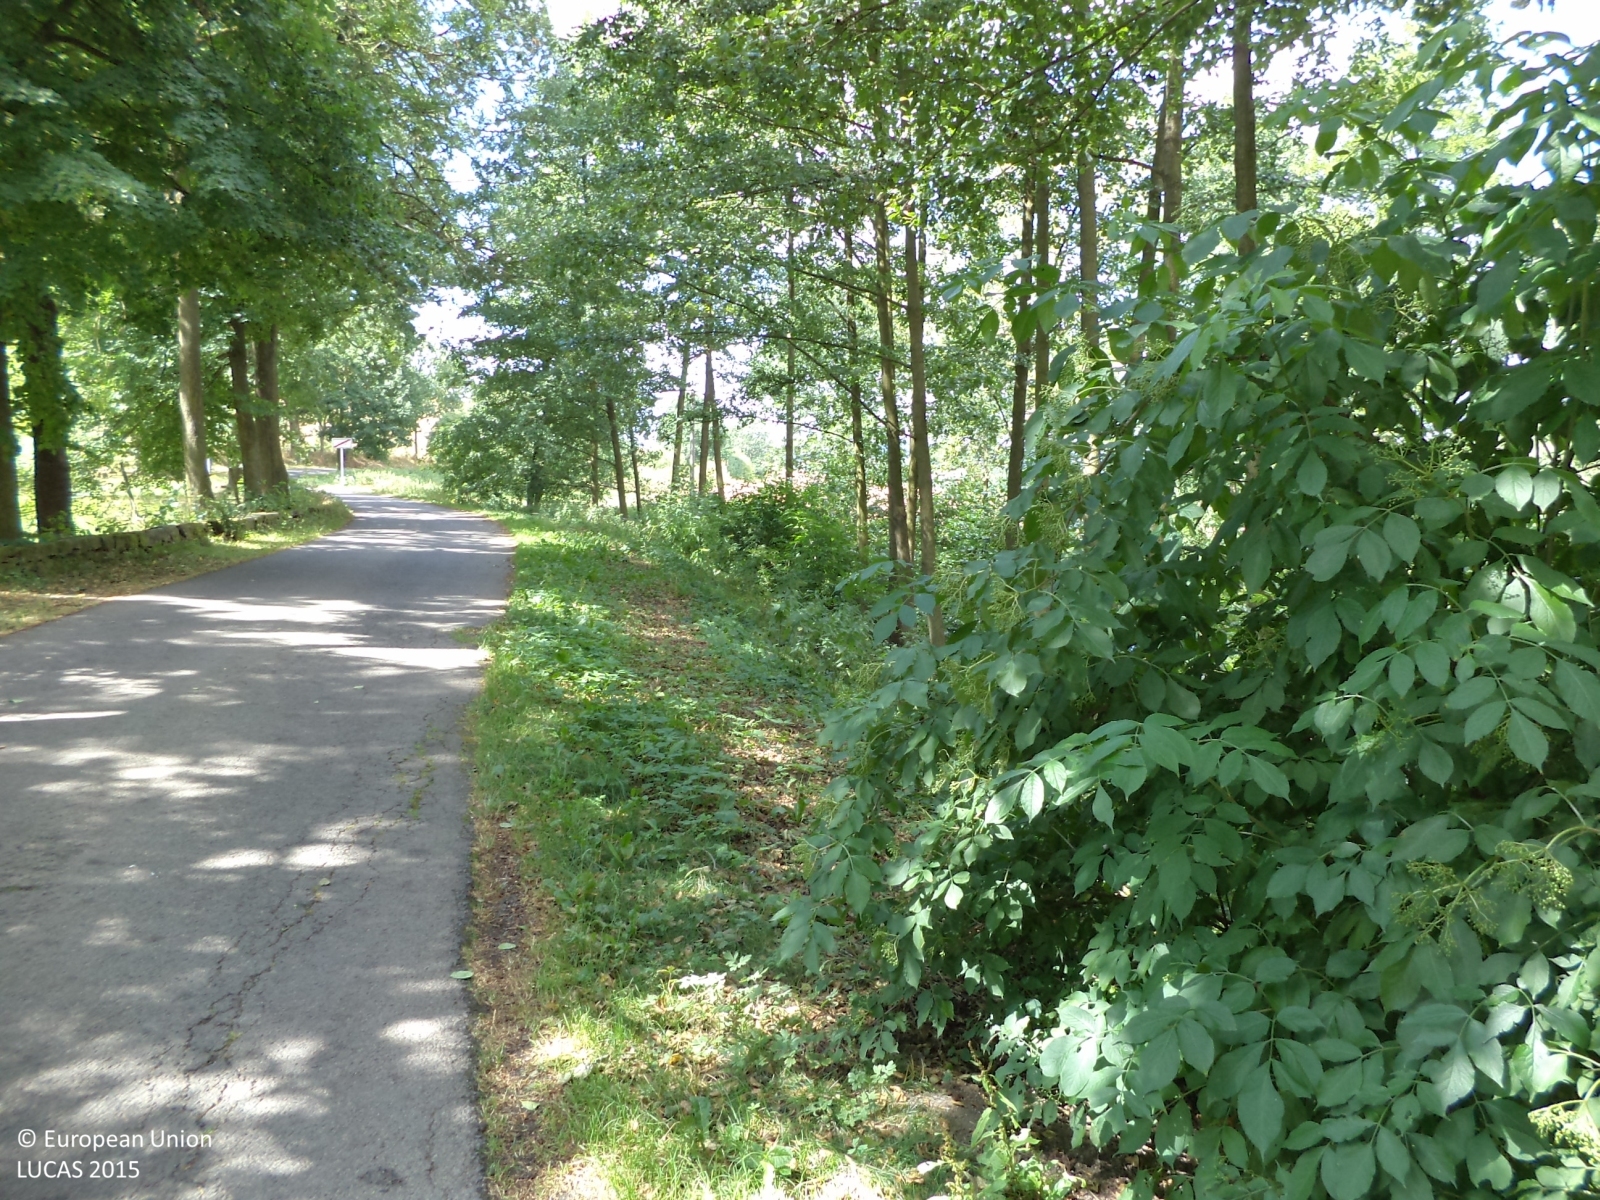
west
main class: Woodland
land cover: Broadleaved woodland
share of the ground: > 75 %
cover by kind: broadleaved forest trees 90 %, herbaceous plants 10 %
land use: Forestry
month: July
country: CZ
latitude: 49.6652
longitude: 14.4489
